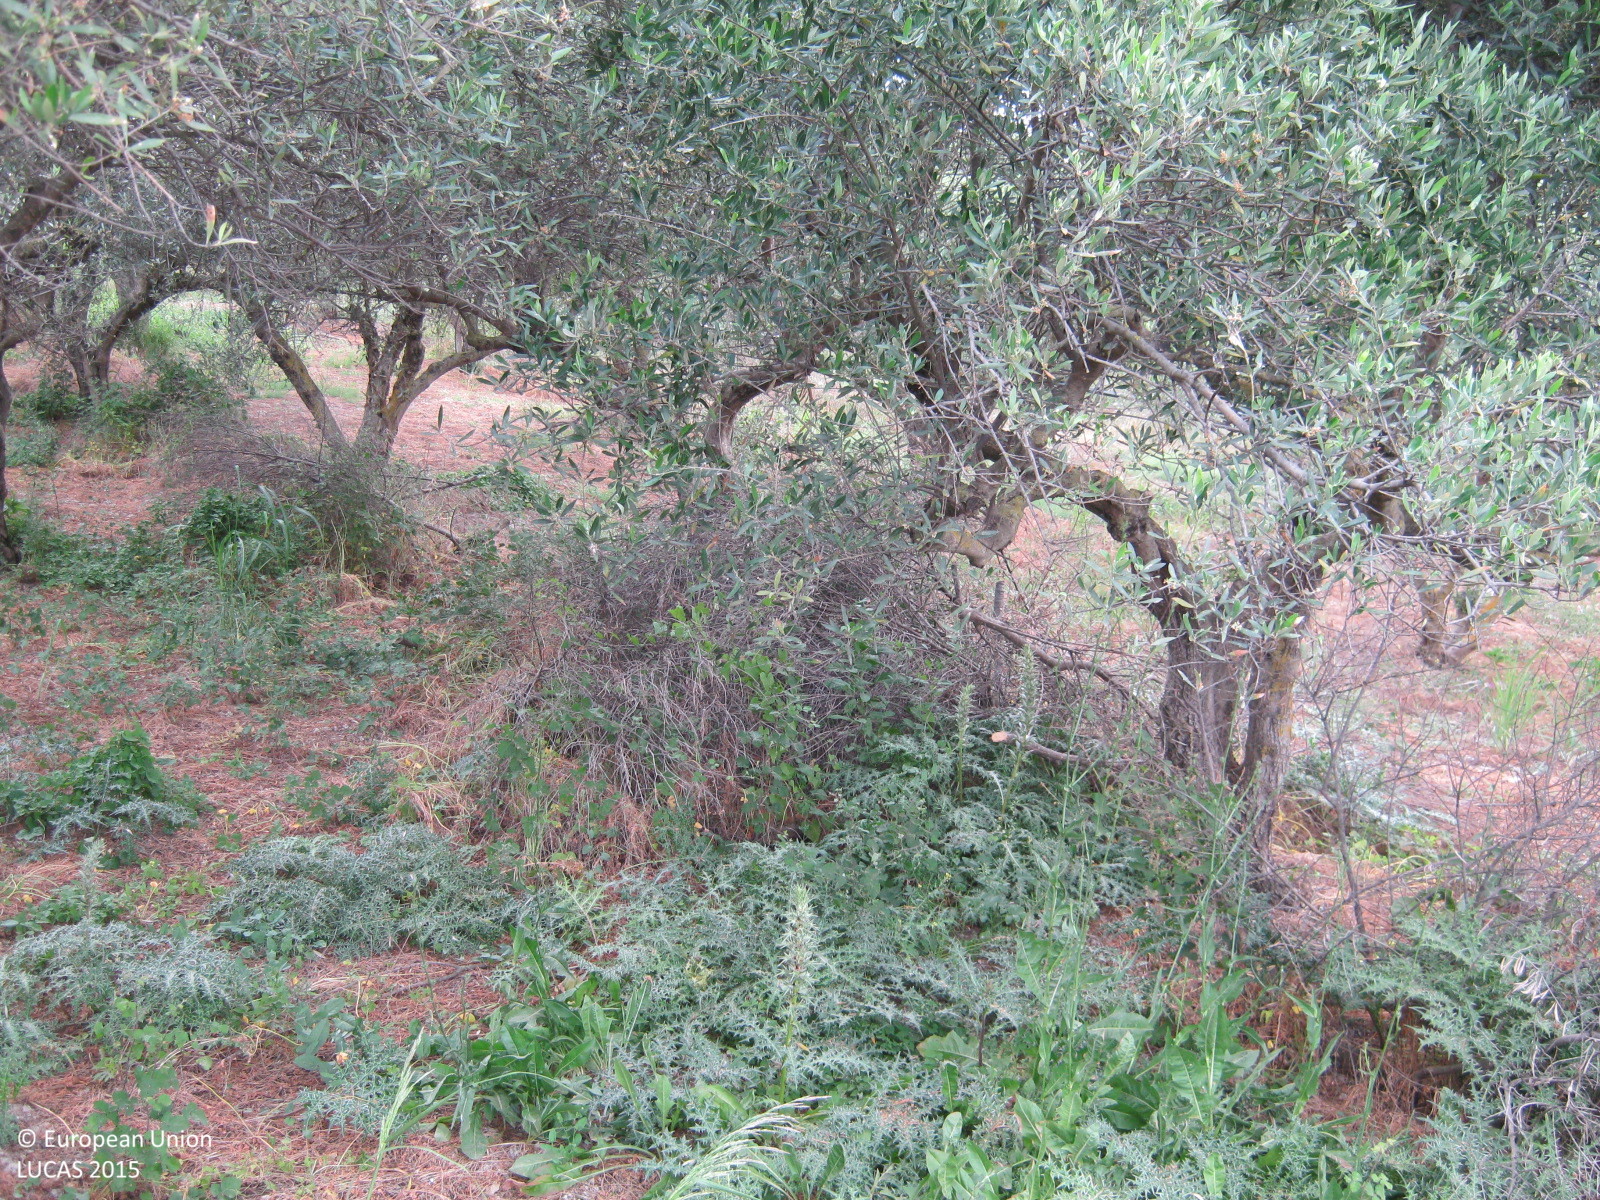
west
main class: Cropland
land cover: Olive groves
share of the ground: > 75 %
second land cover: Spontaneously vegetated surfaces
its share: > 75 %
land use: Agriculture (excluding fallow land and kitchen gardens)
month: May
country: GR
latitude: 35.4867
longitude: 23.7949
